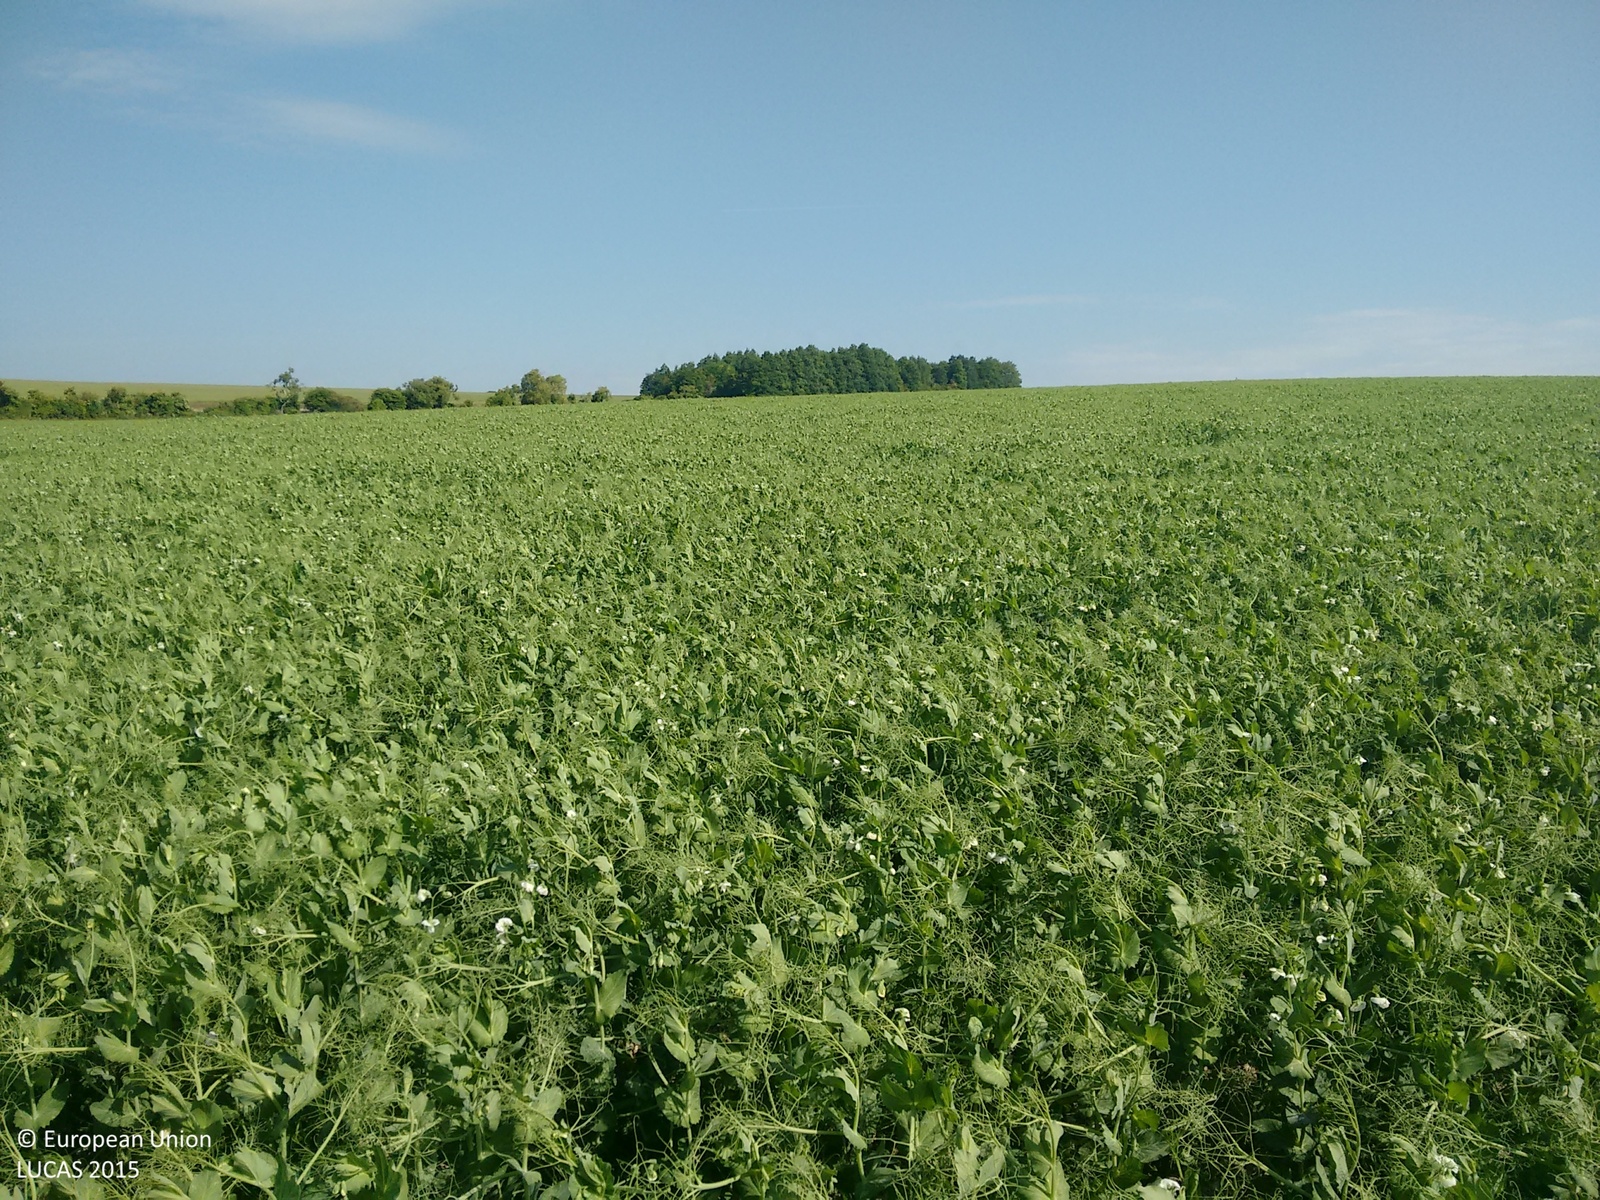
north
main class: Cropland
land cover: Dry pulses
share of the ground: > 75 %
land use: Agriculture (excluding fallow land and kitchen gardens)
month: June
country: GB
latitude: 51.1247
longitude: -1.8728
